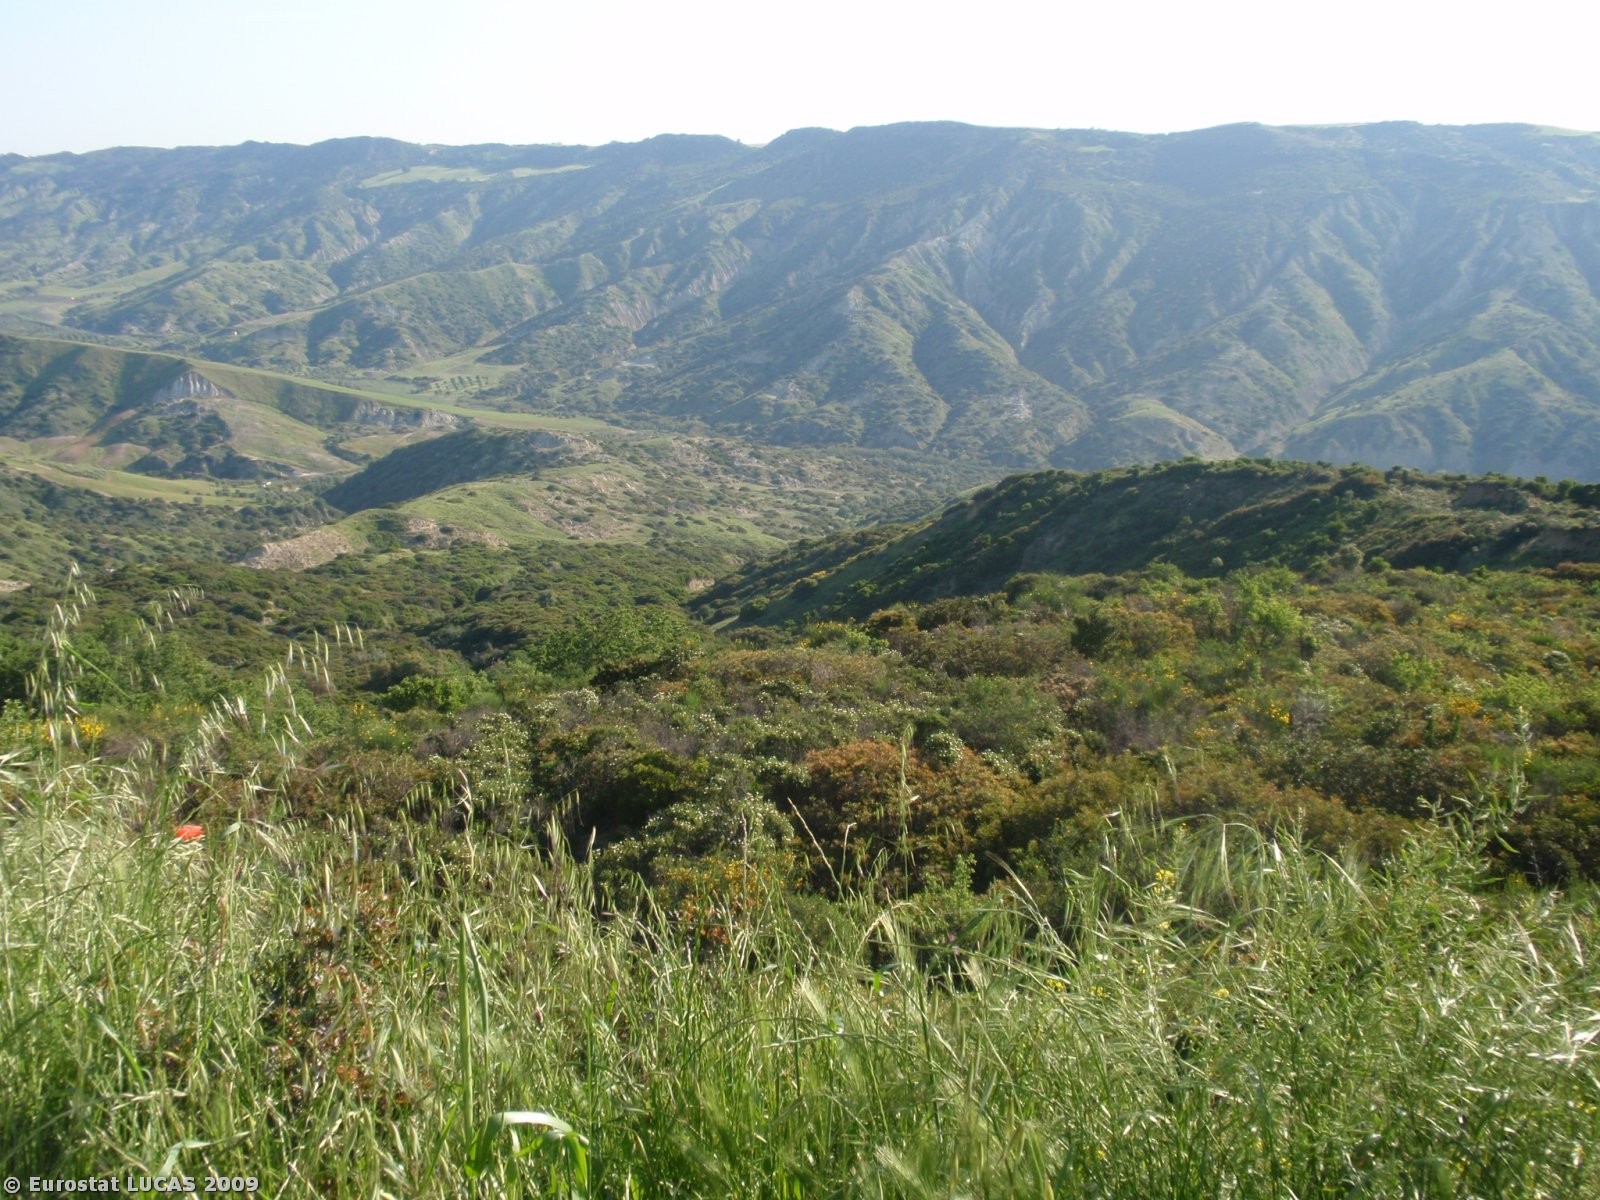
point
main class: Shrubland
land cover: Shrubland without tree cover
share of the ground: > 75 %
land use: Unused
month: May
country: IT
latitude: 40.4825
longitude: 16.5702
